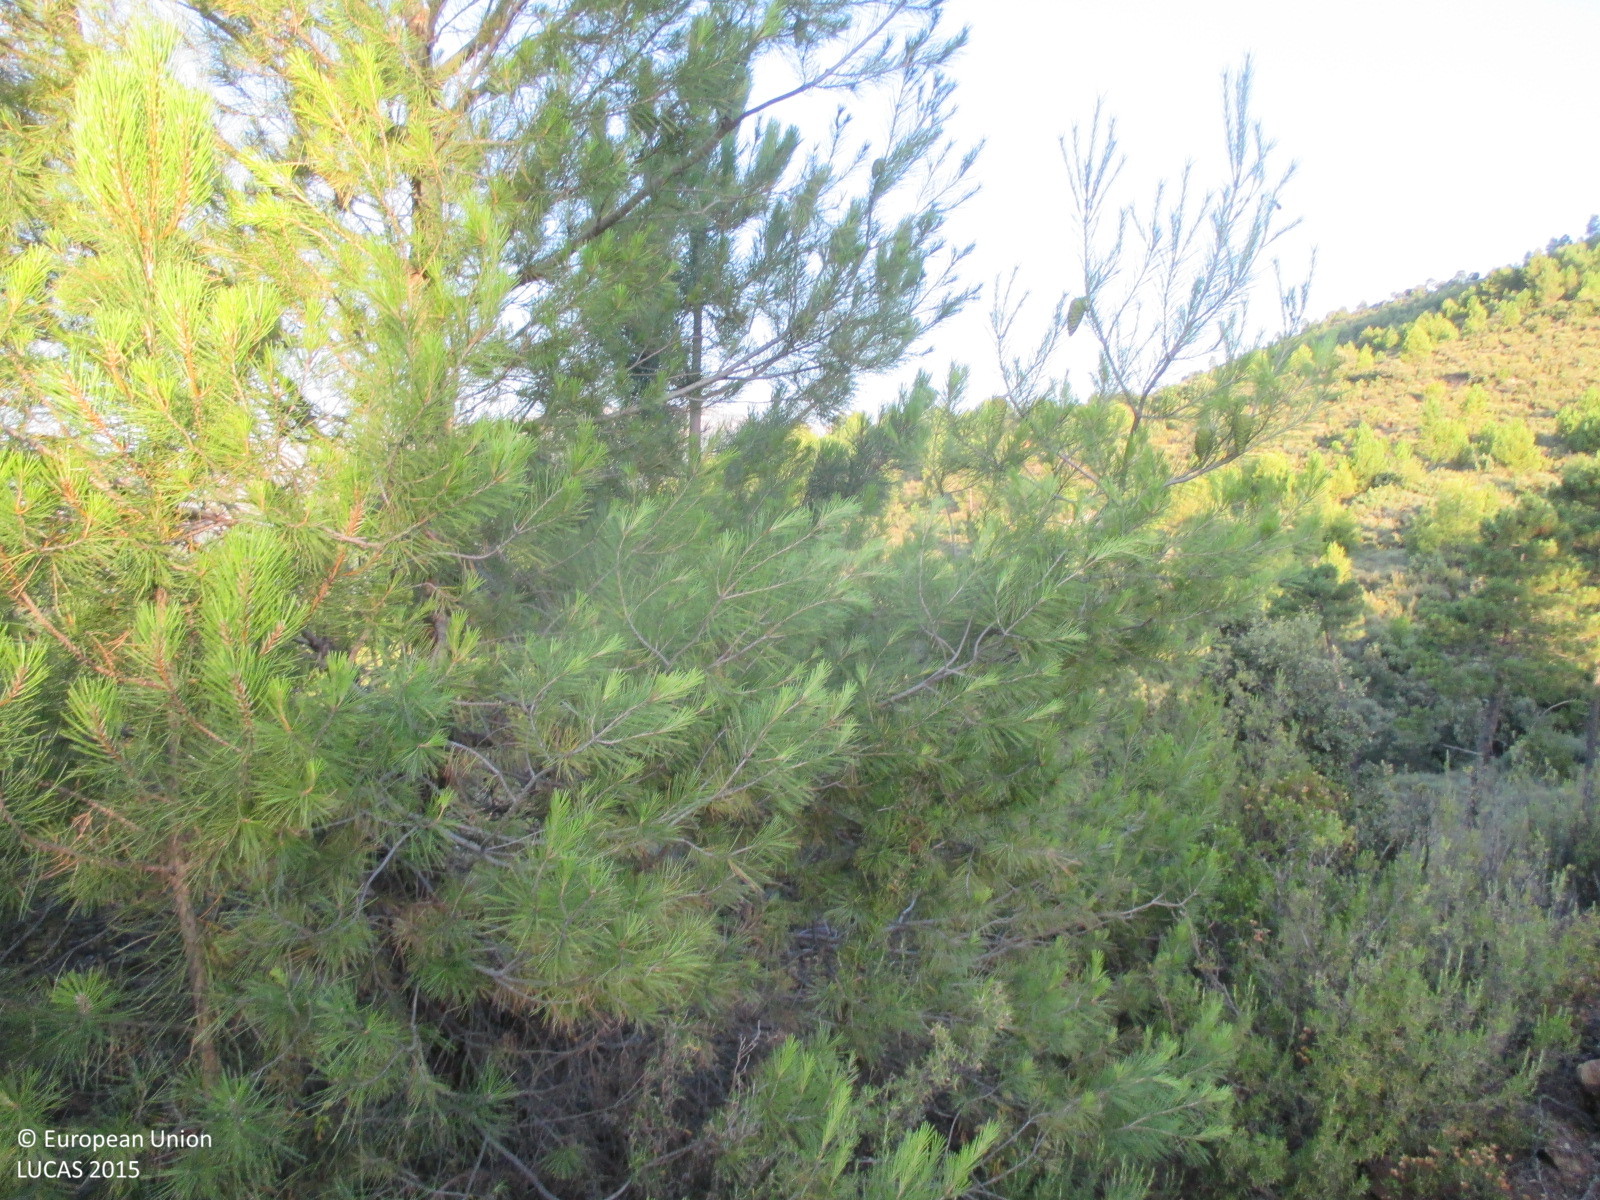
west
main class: Woodland
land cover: Pine dominated coniferous woodland
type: coniferous forest of the mediterranean region
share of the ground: 25 - 50 %
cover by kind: coniferous forest trees 40 %, shrubs 40 %, herbaceous plants 20 %
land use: Forestry
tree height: > 5 m
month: July
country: ES
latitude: 38.3447
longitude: -2.3875
